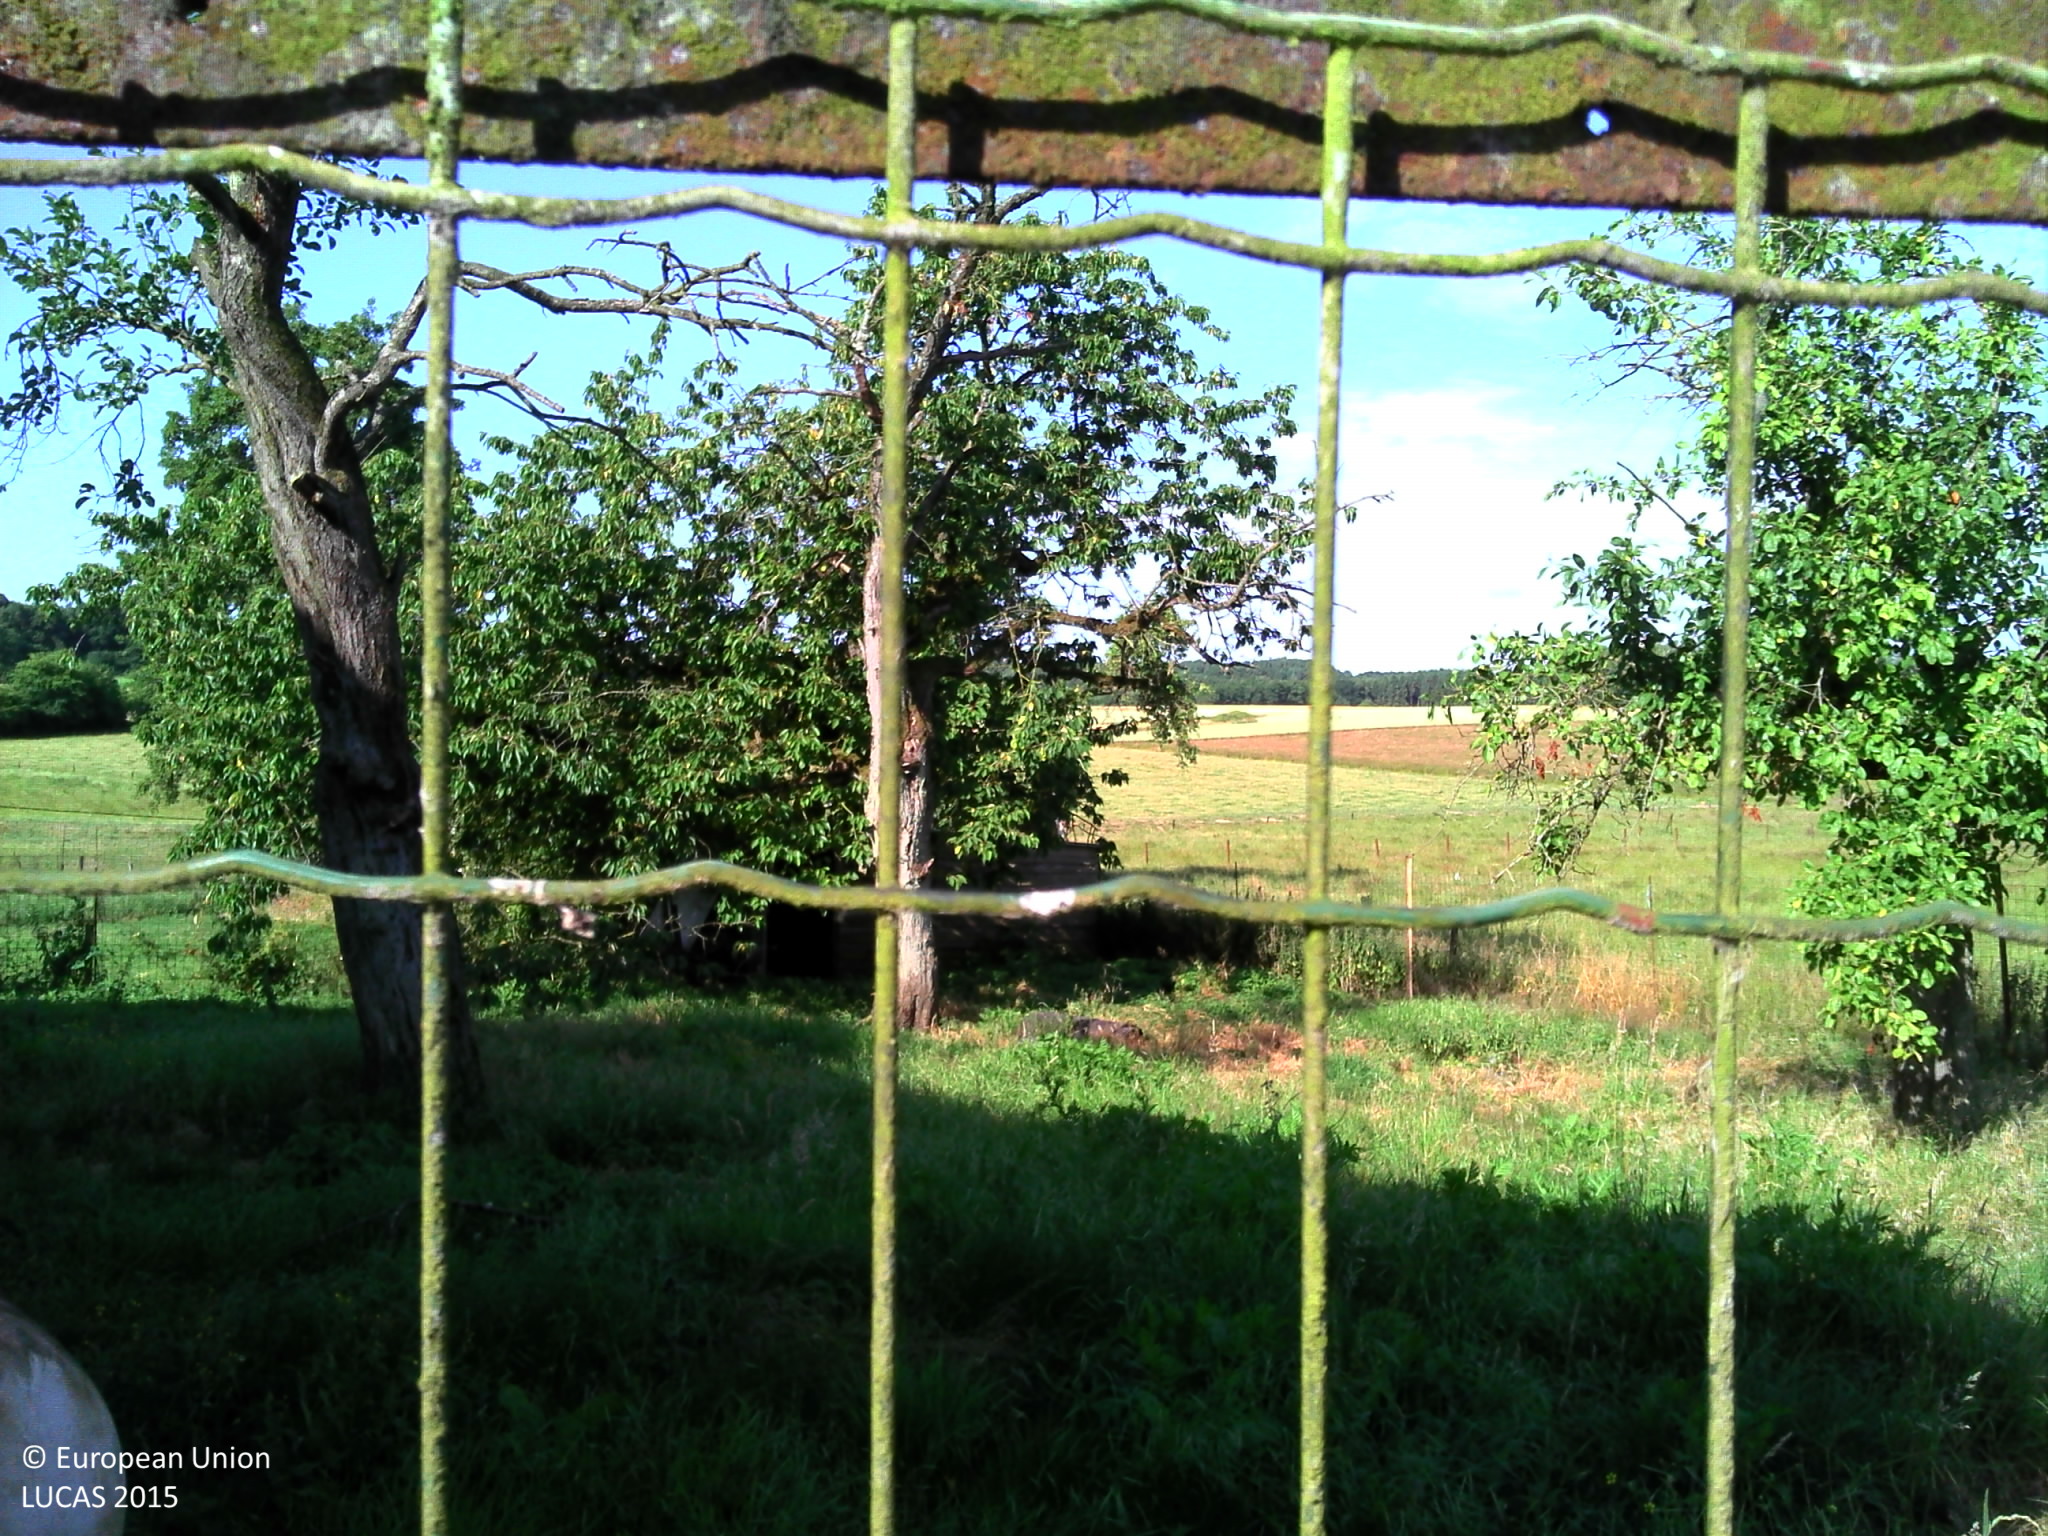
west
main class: Grassland
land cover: Grassland with sparse tree/shrub cover
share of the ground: > 75 %
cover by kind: herbaceous plants 95 %, broadleaved forest trees 5 %
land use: Residential
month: July
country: BE
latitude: 50.2916
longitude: 4.6203
